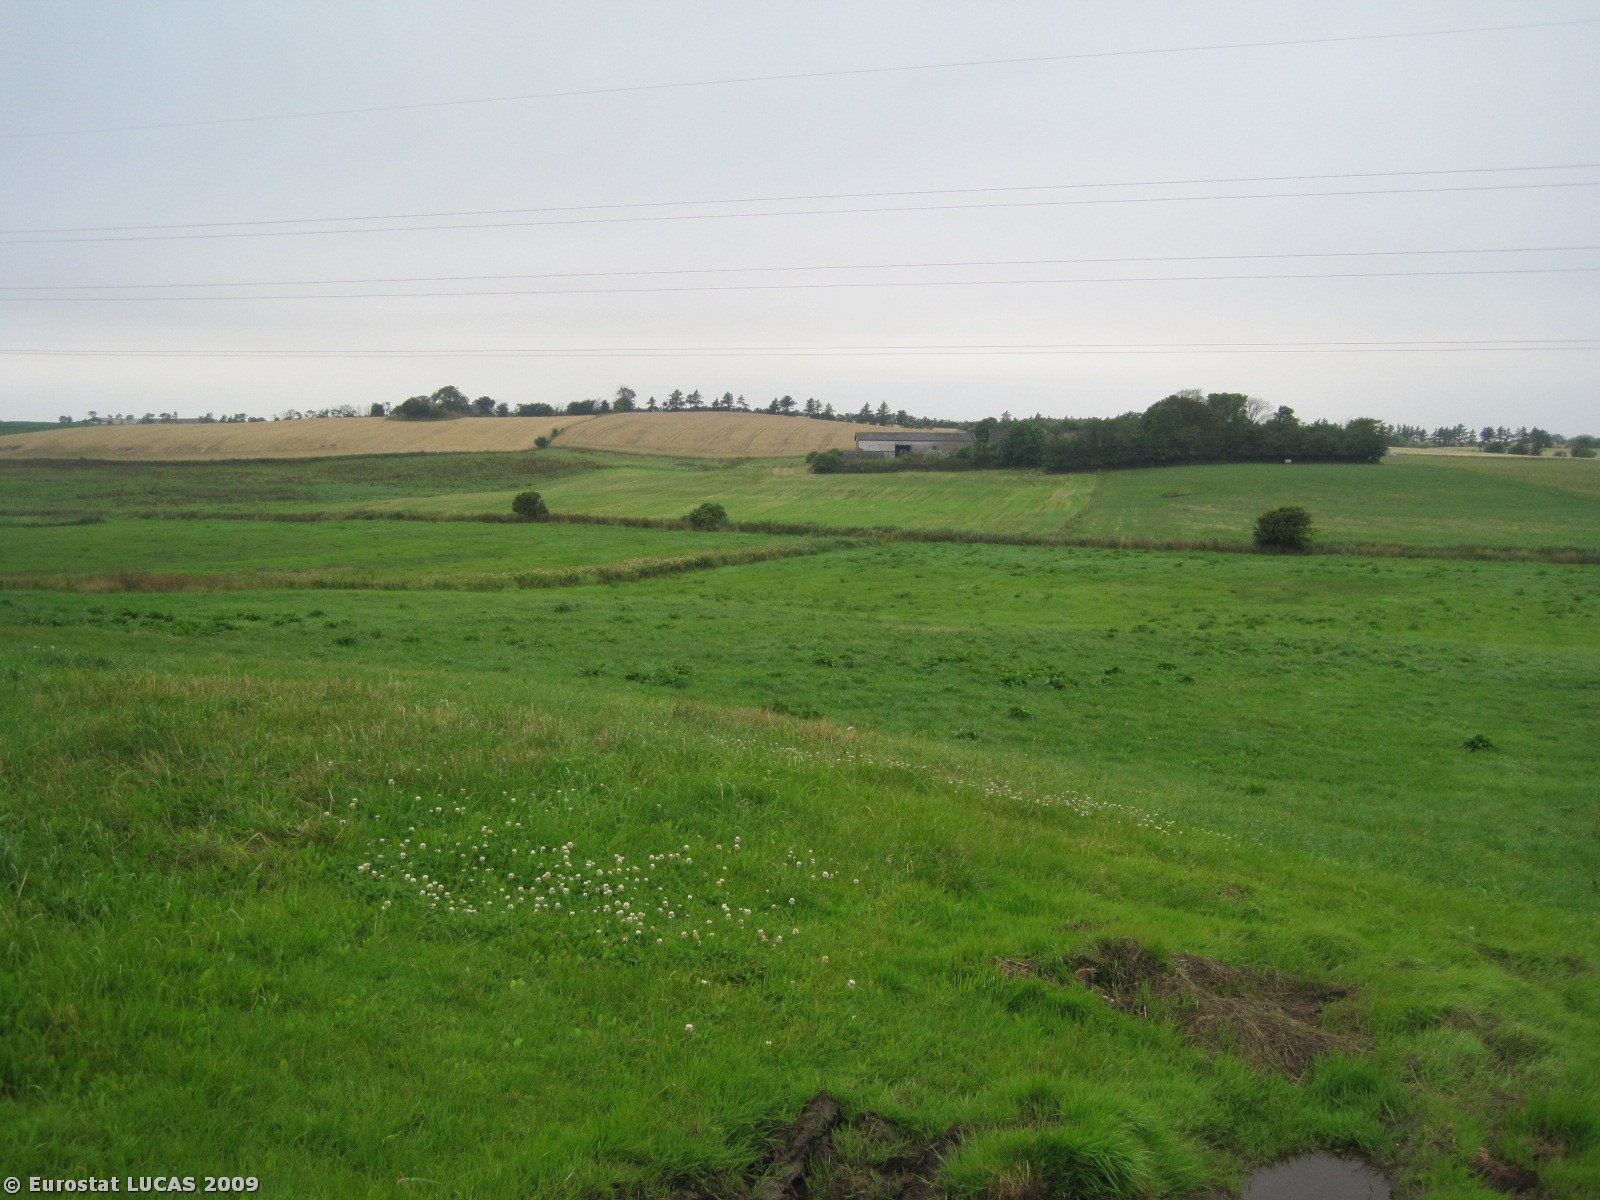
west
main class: Grassland
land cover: Grassland without tree/shrub cover
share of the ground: > 75 %
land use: Agriculture (excluding fallow land and kitchen gardens)
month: July
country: DK
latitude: 56.8811
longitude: 8.5743
